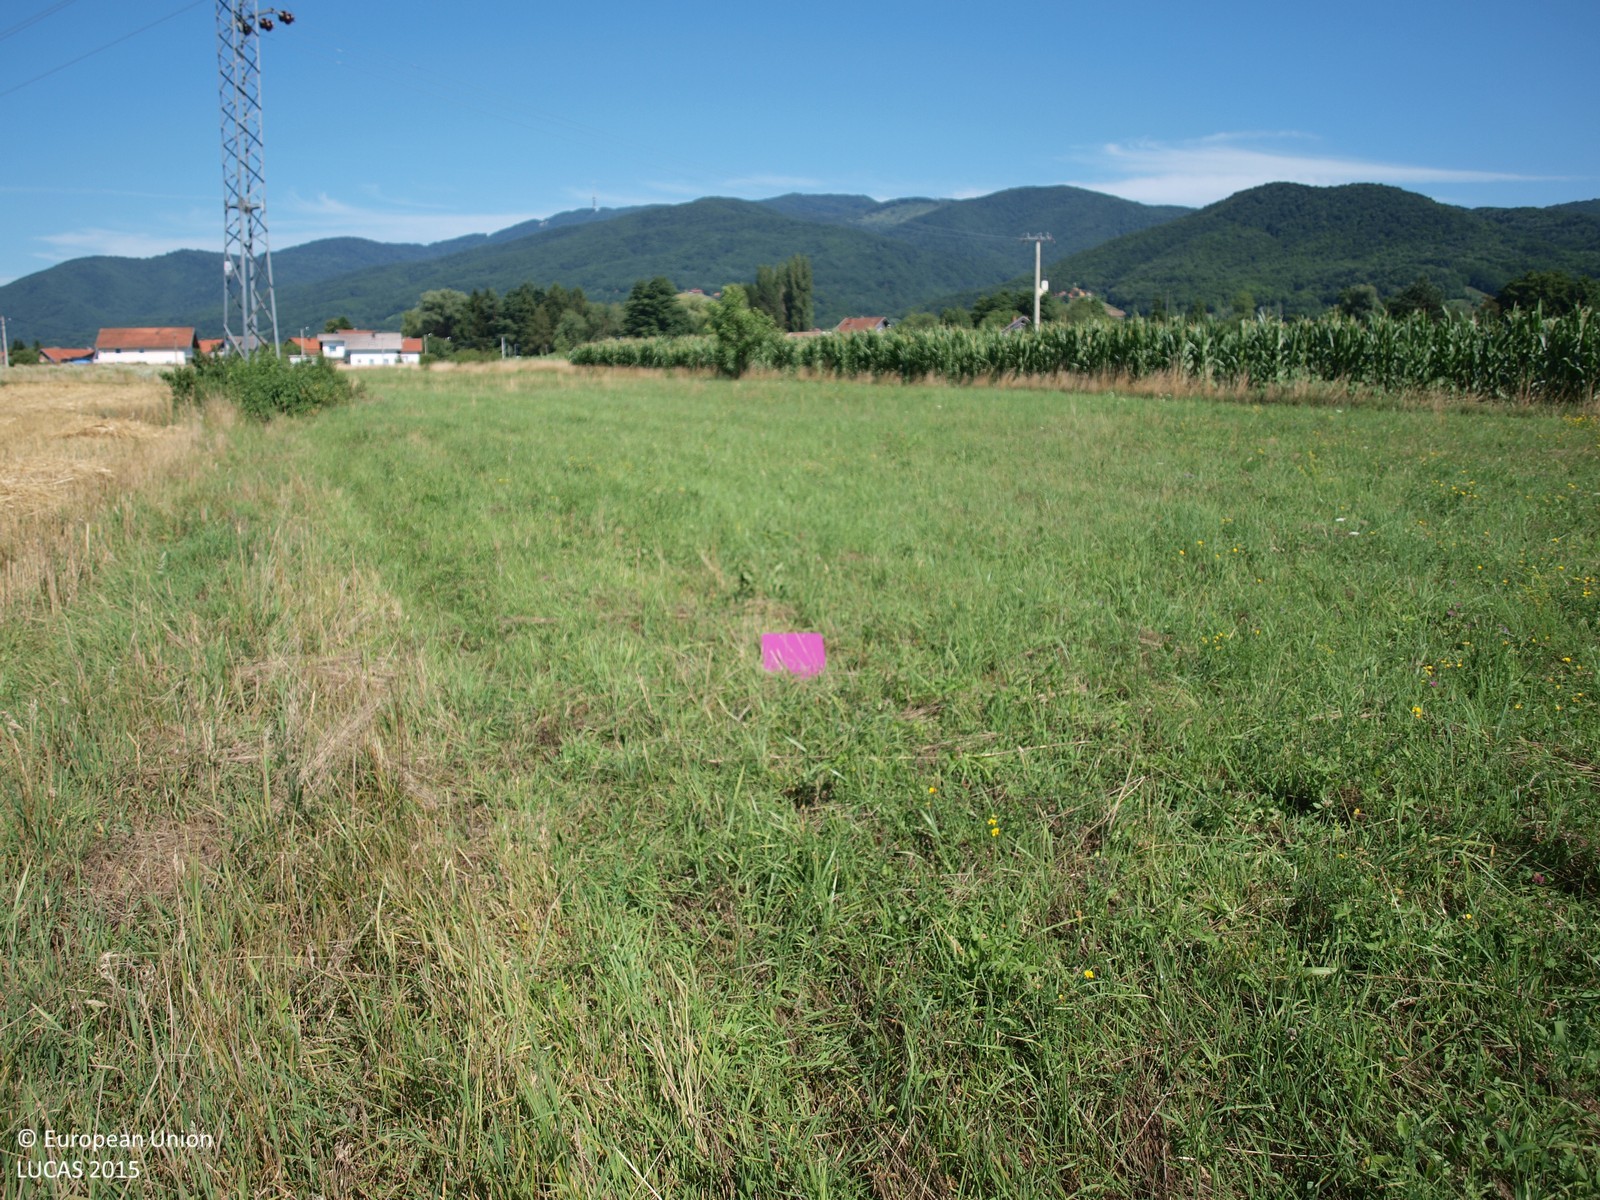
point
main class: Grassland
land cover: Grassland without tree/shrub cover
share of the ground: > 75 %
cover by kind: herbaceous plants 100 %
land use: Agriculture (excluding fallow land and kitchen gardens)
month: July
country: HR
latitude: 45.9015
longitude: 15.8626
